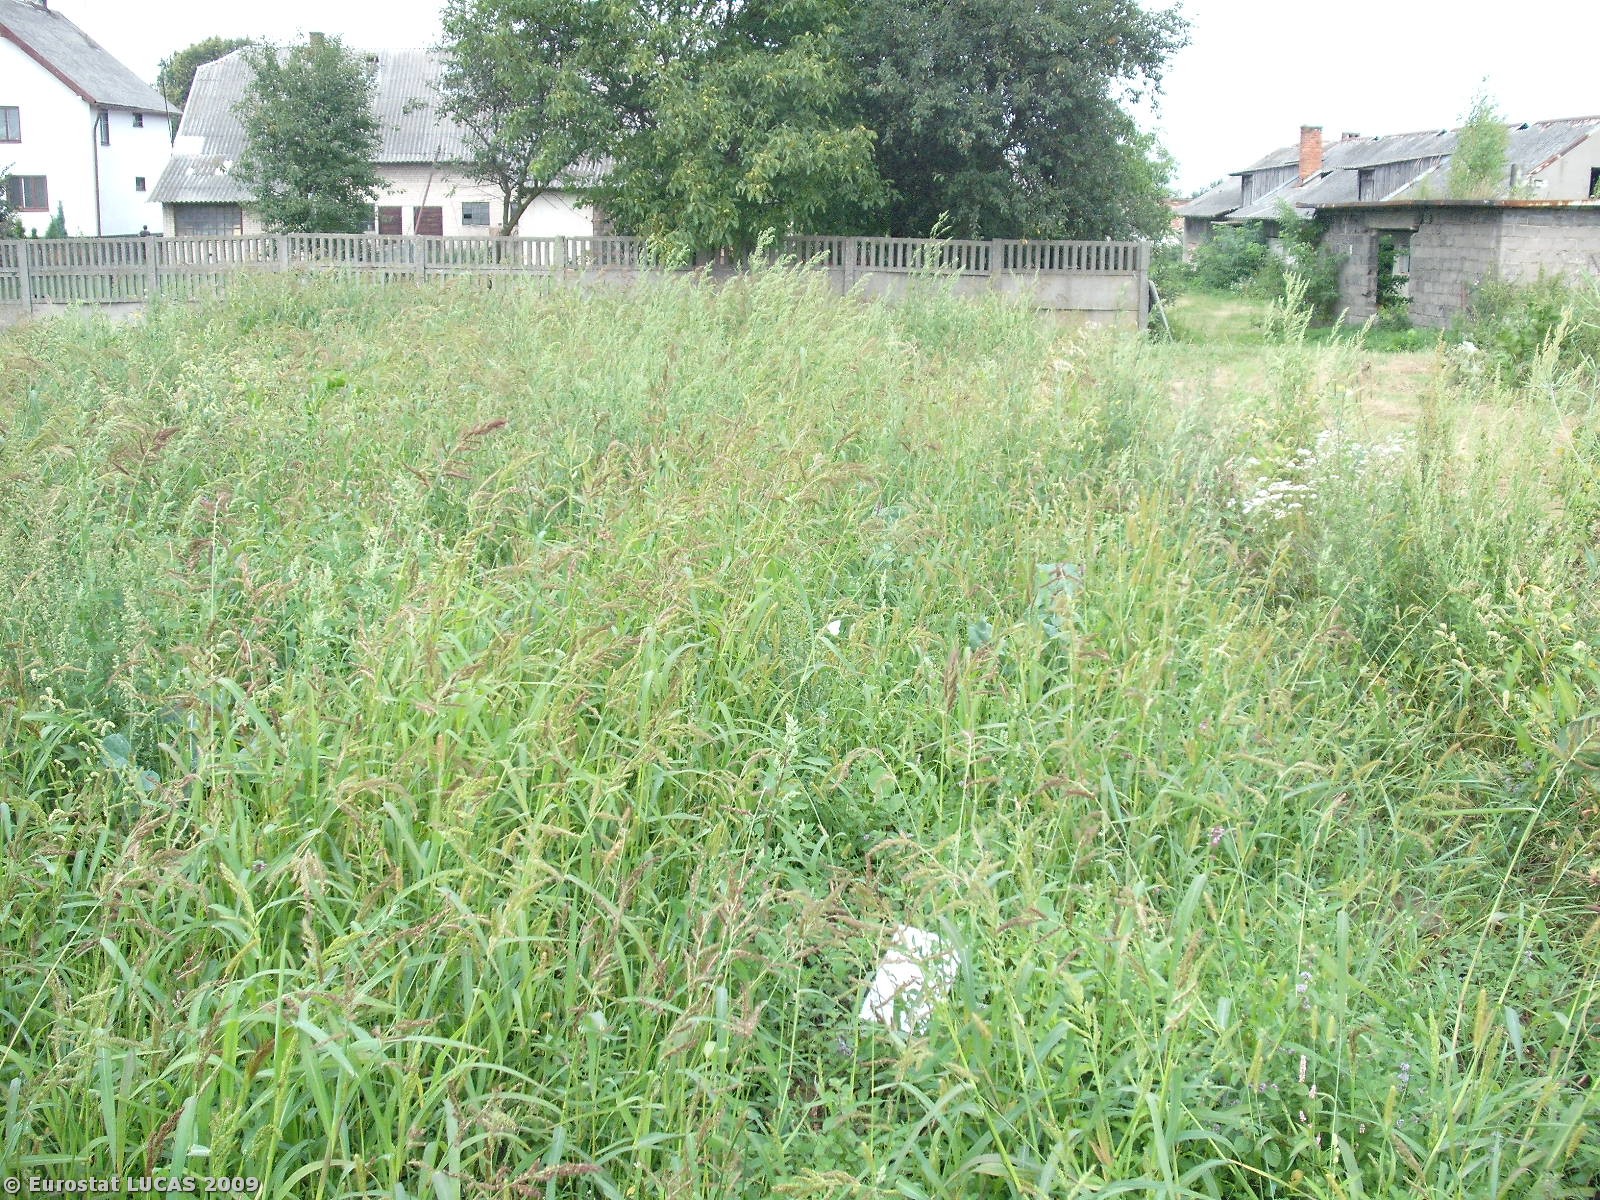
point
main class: Grassland
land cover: Grassland without tree/shrub cover
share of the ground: > 75 %
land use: Agriculture (excluding fallow land and kitchen gardens)
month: August
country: PL
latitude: 50.0646
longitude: 22.5979
